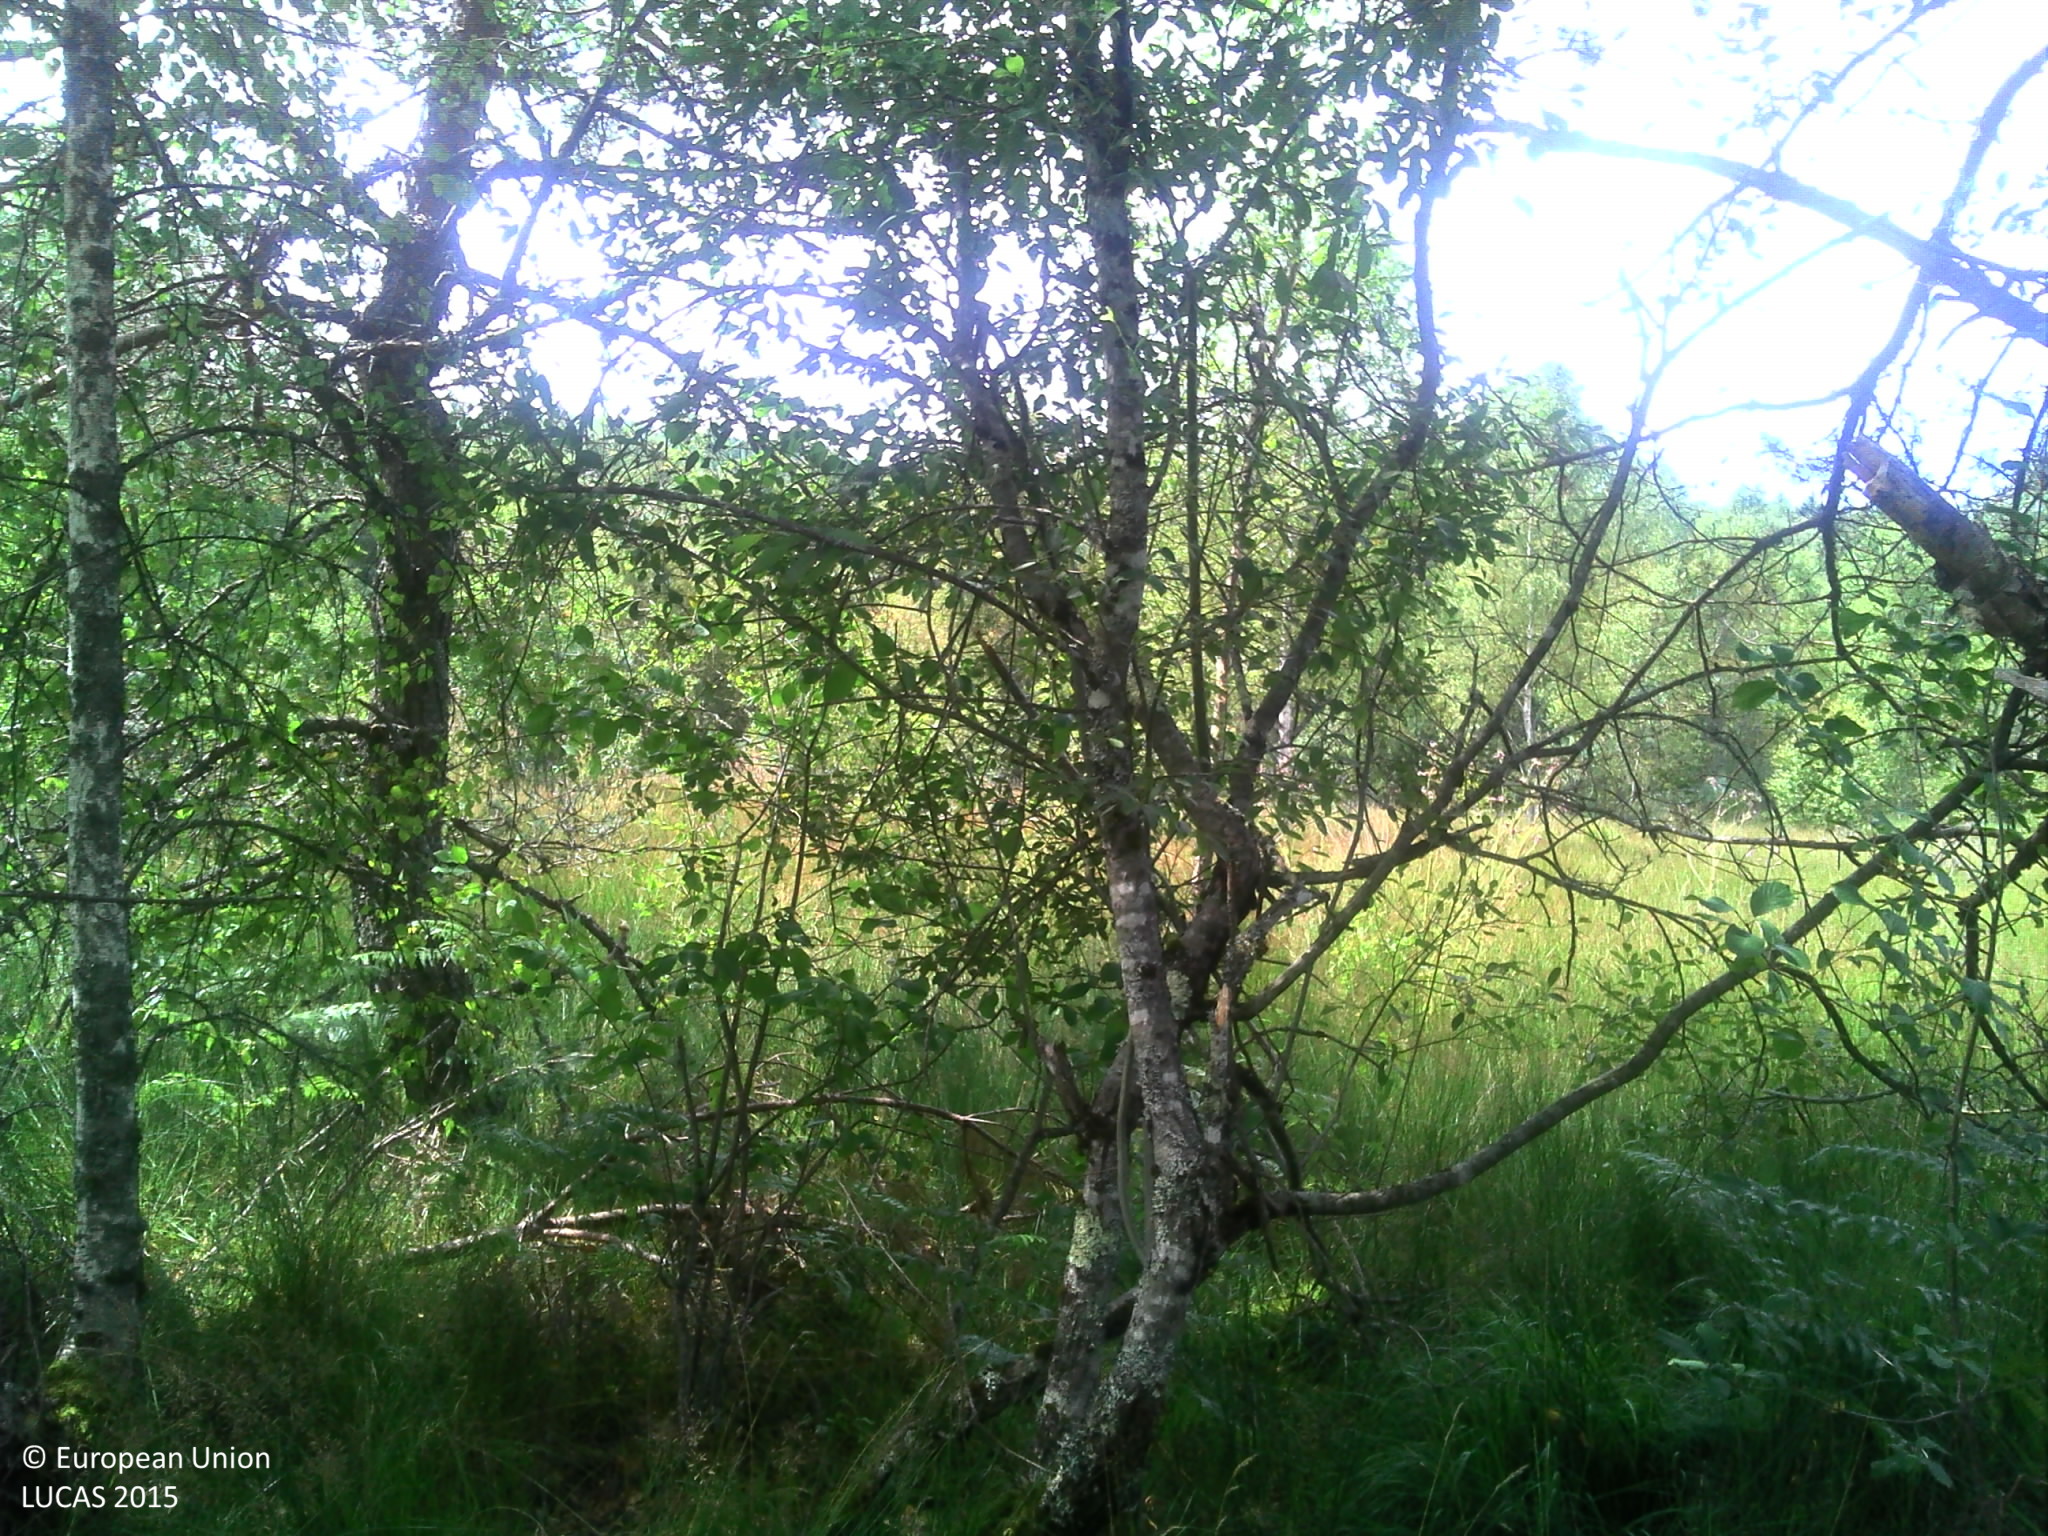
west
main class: Woodland
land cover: Broadleaved woodland
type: non-riverine alder, birch or aspen forest
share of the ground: > 75 %
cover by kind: shrubs 45 %, broadleaved forest trees 35 %, herbaceous plants 20 %
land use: Semi-natural and natural areas not in use
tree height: > 5 m
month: July
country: FR
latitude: 45.6236
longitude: 1.8507
